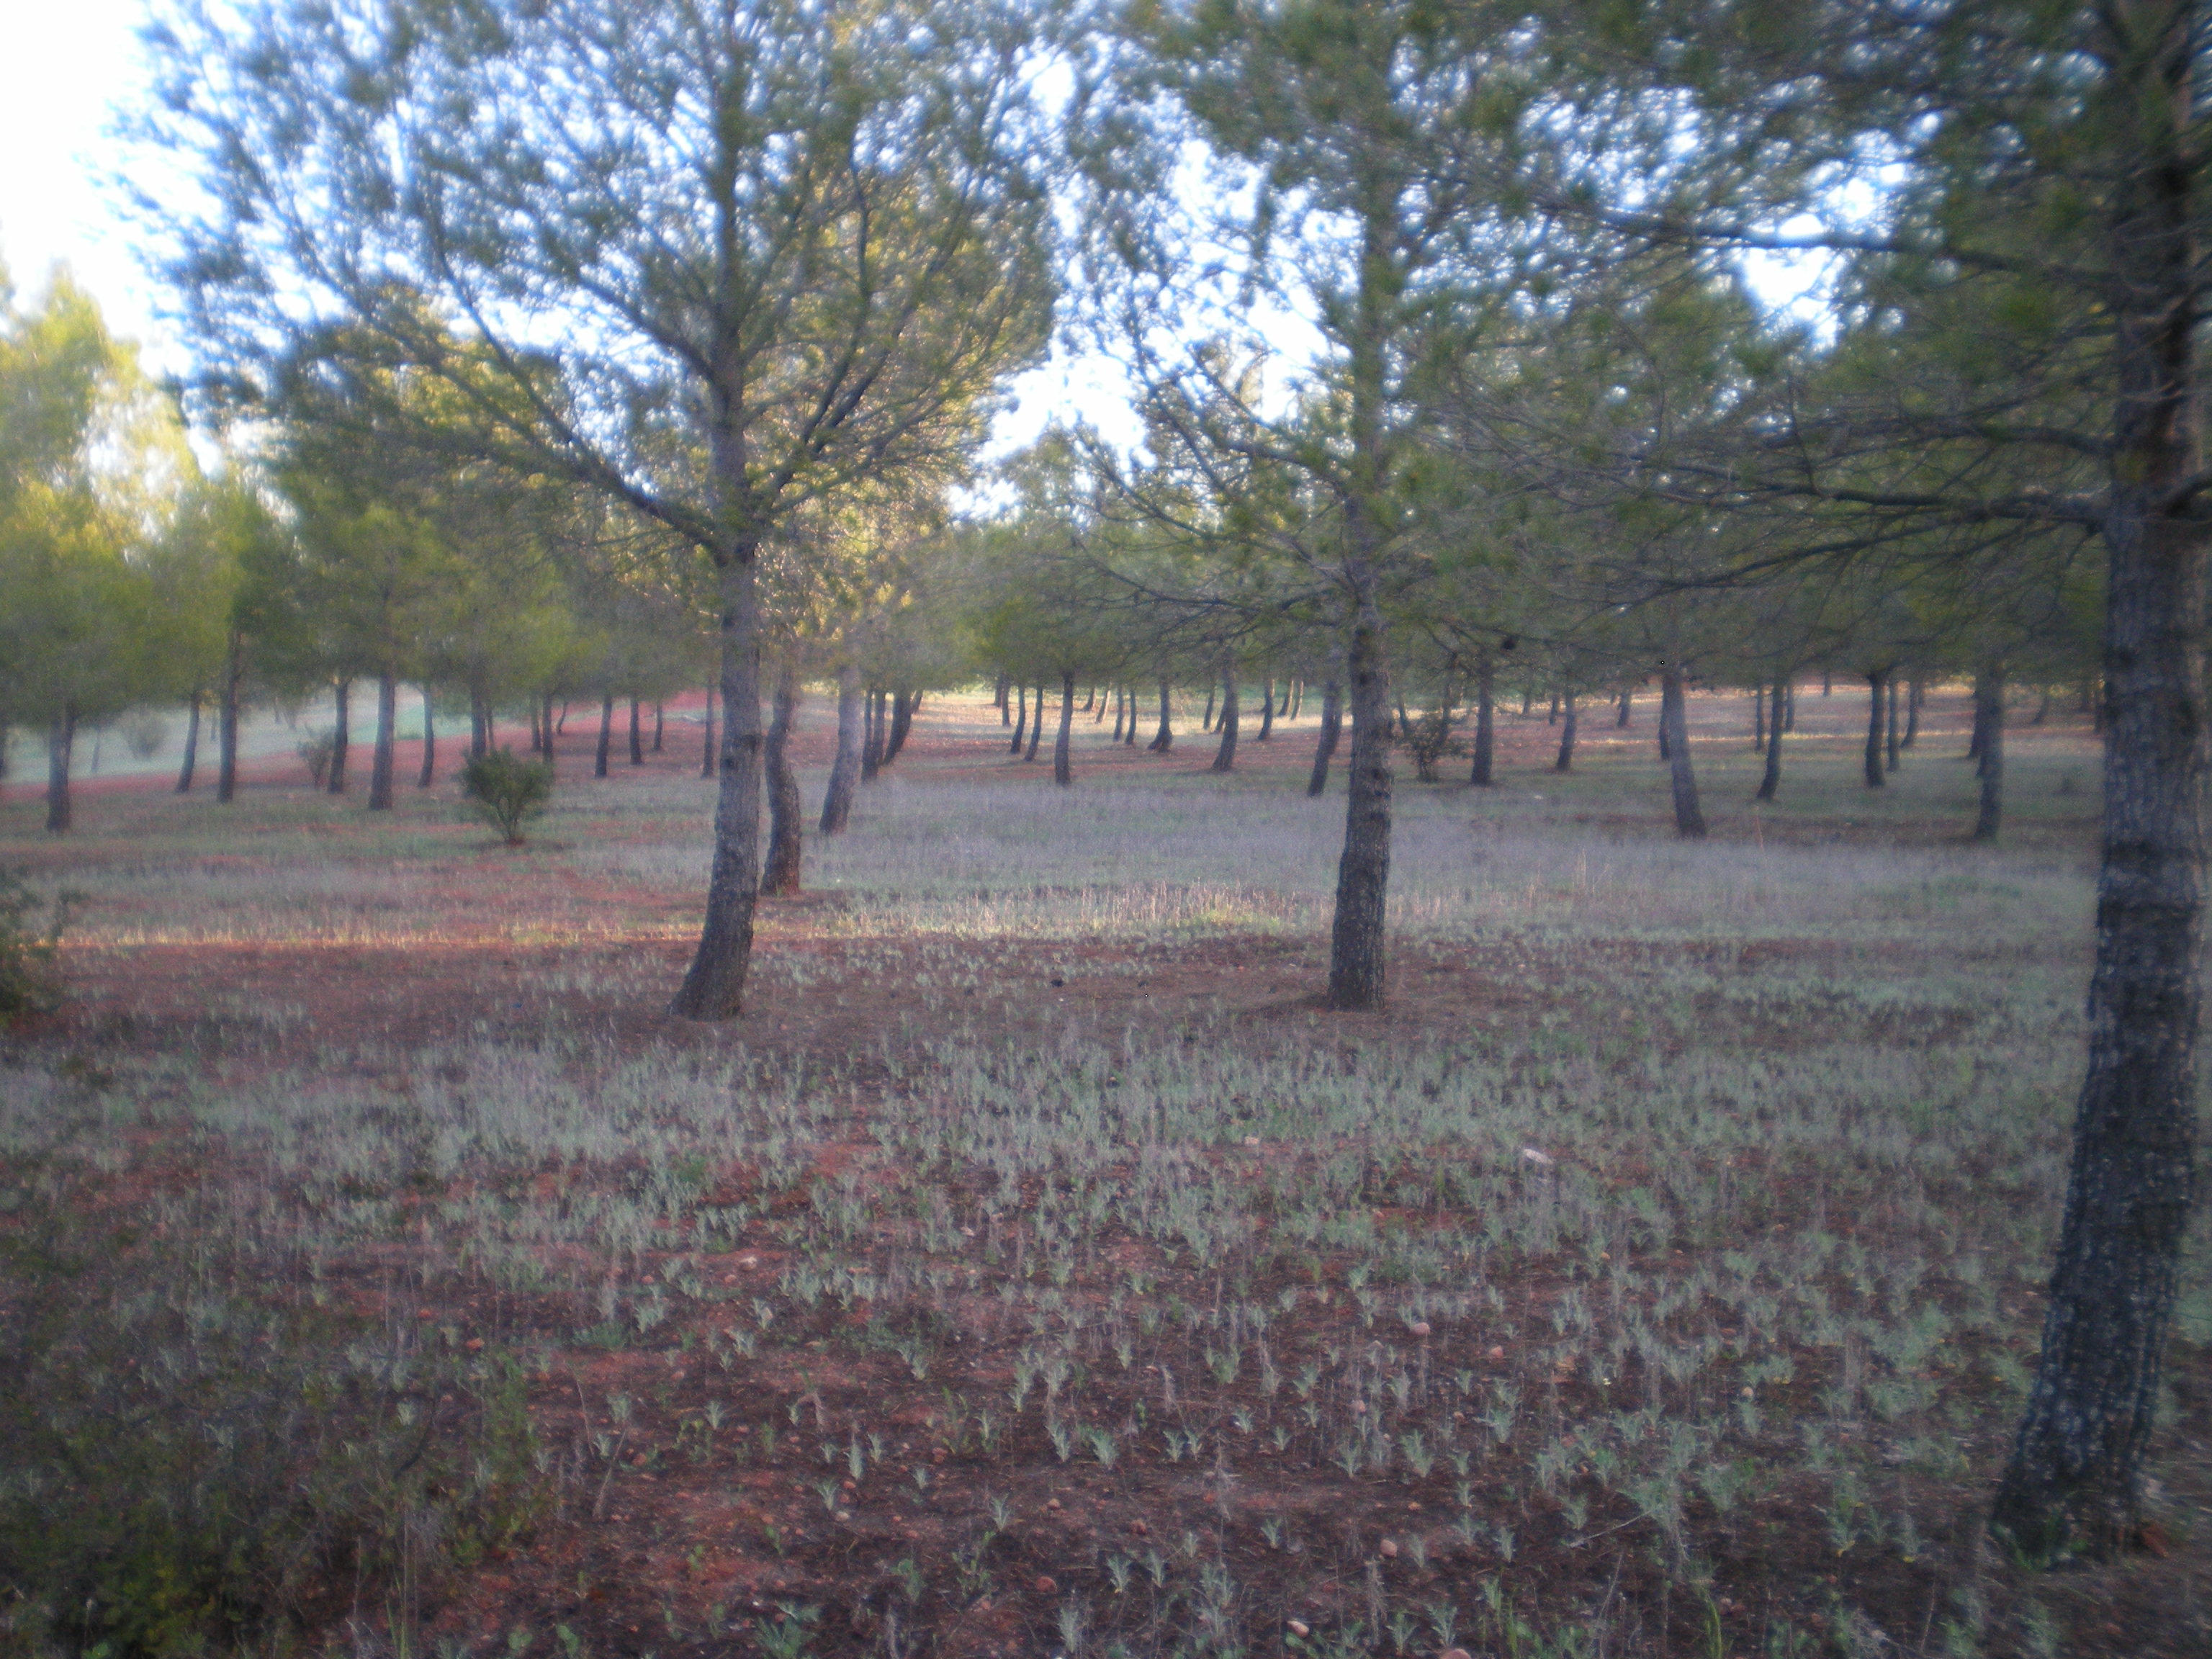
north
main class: Woodland
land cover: Pine dominated coniferous woodland
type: coniferous forest of the mediterranean region
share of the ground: 50 - 75 %
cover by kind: coniferous forest trees 60 %, herbaceous plants 25 %, unconsolidated bare surface 10 %, broadleaved forest trees 5 %
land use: Forestry
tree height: > 5 m
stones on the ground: < 10 %
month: April
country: ES
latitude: 38.6980
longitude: -3.0337
